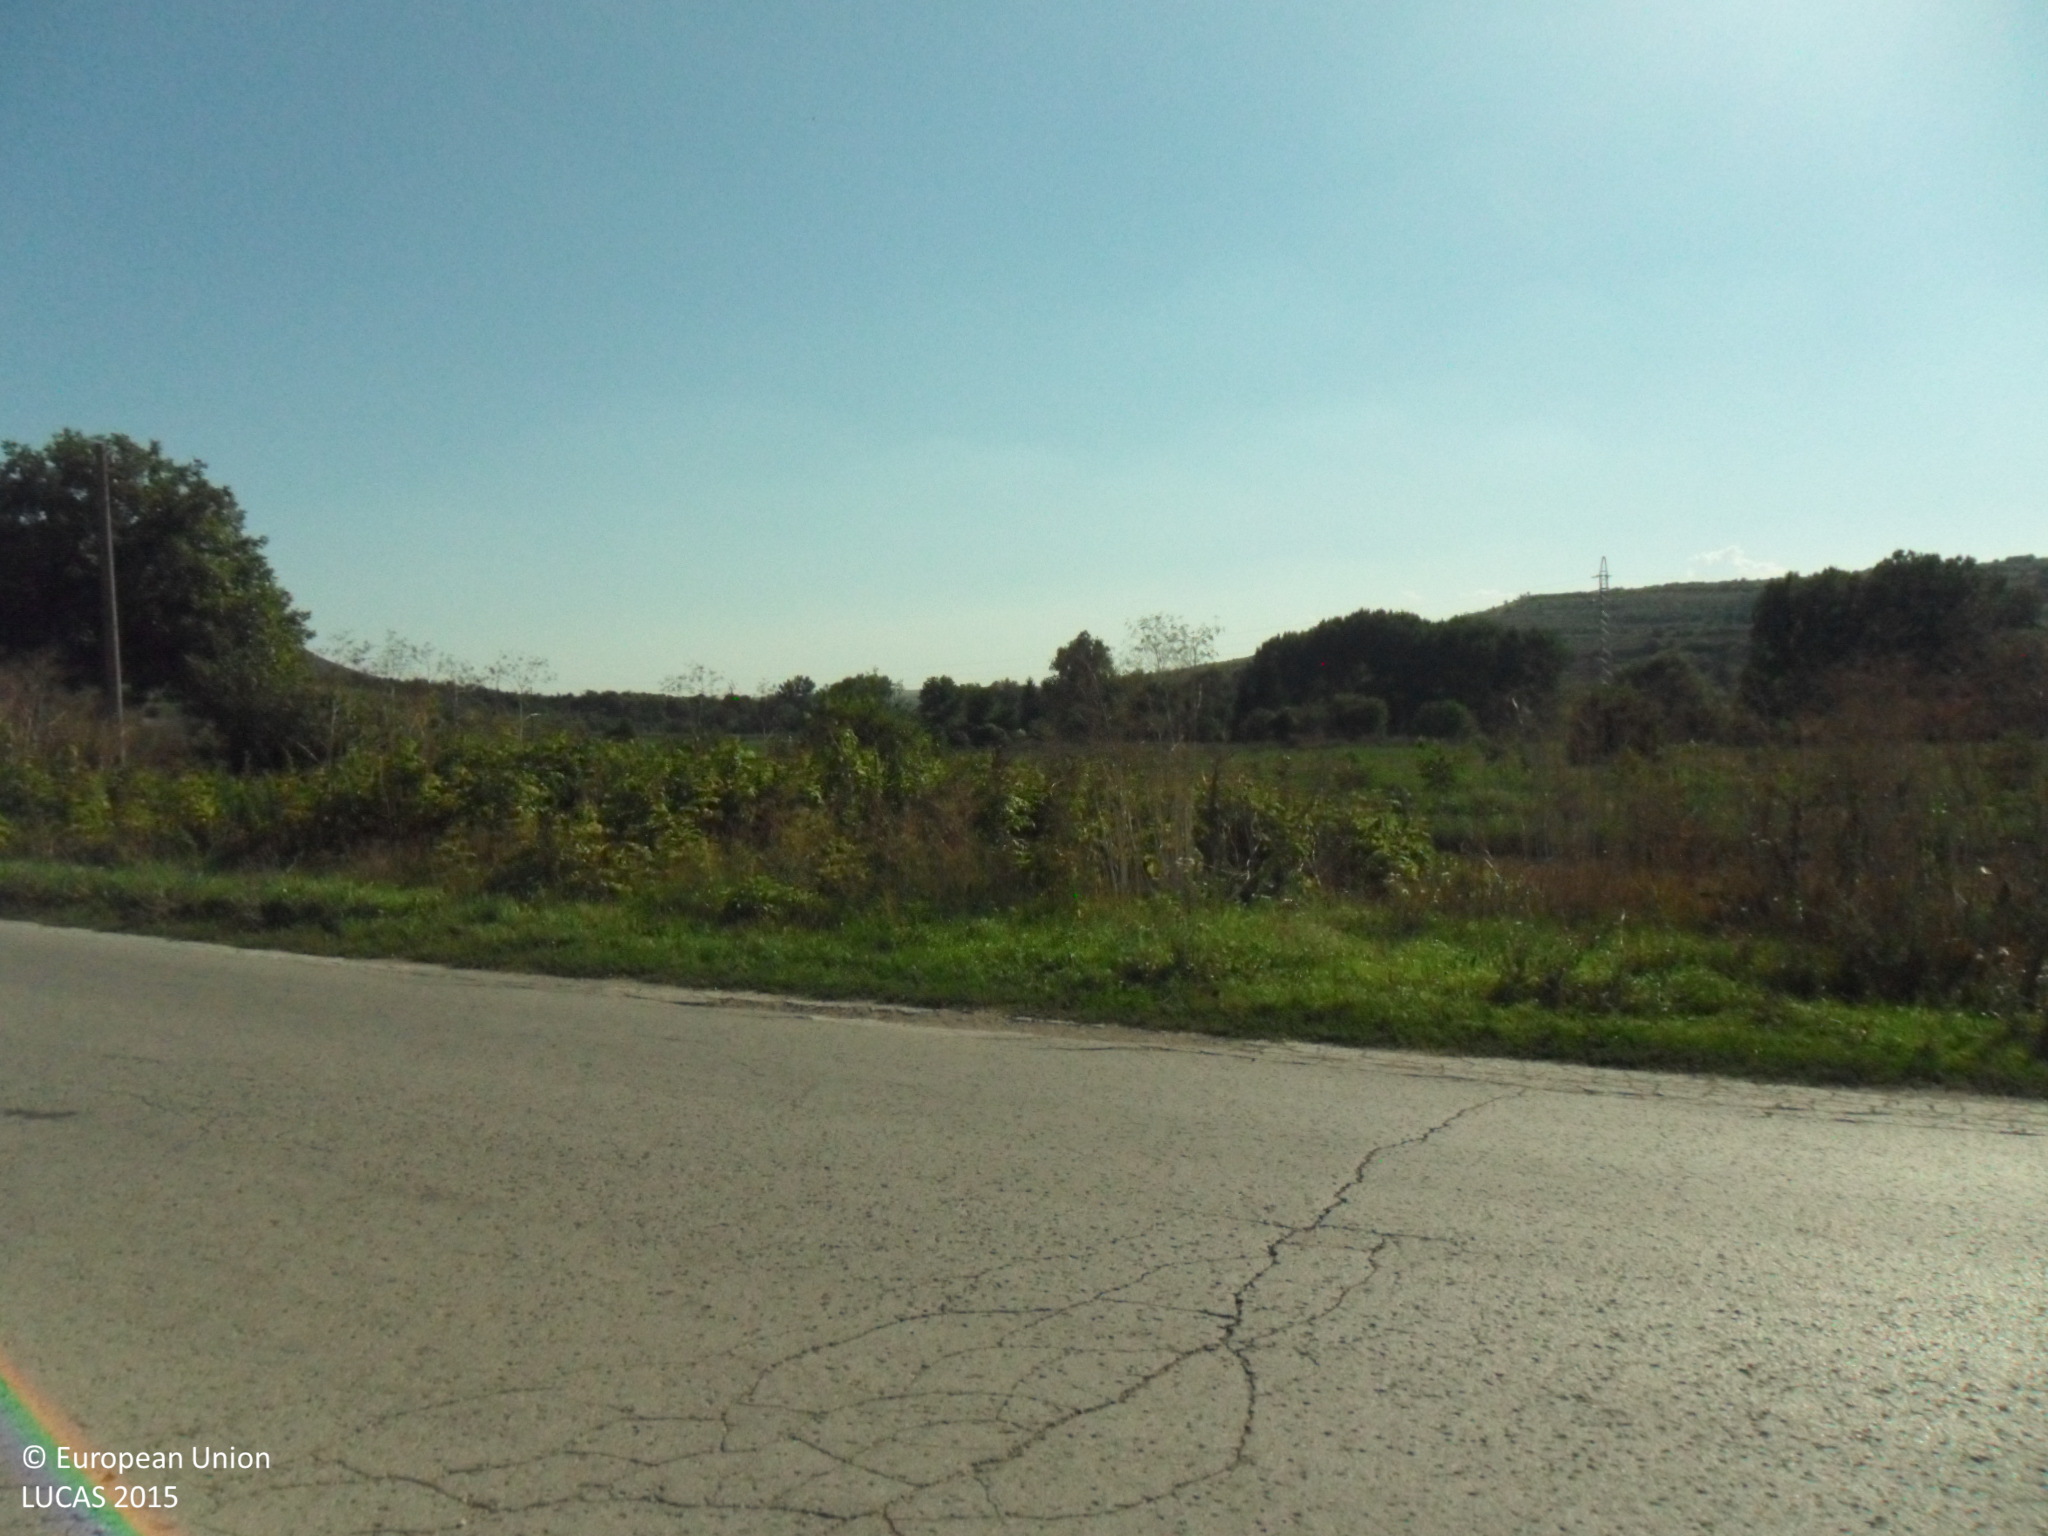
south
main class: Cropland
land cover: Tomatoes
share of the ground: > 75 %
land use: Kitchen garden
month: September
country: BG
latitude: 43.4770
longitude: 27.1699
